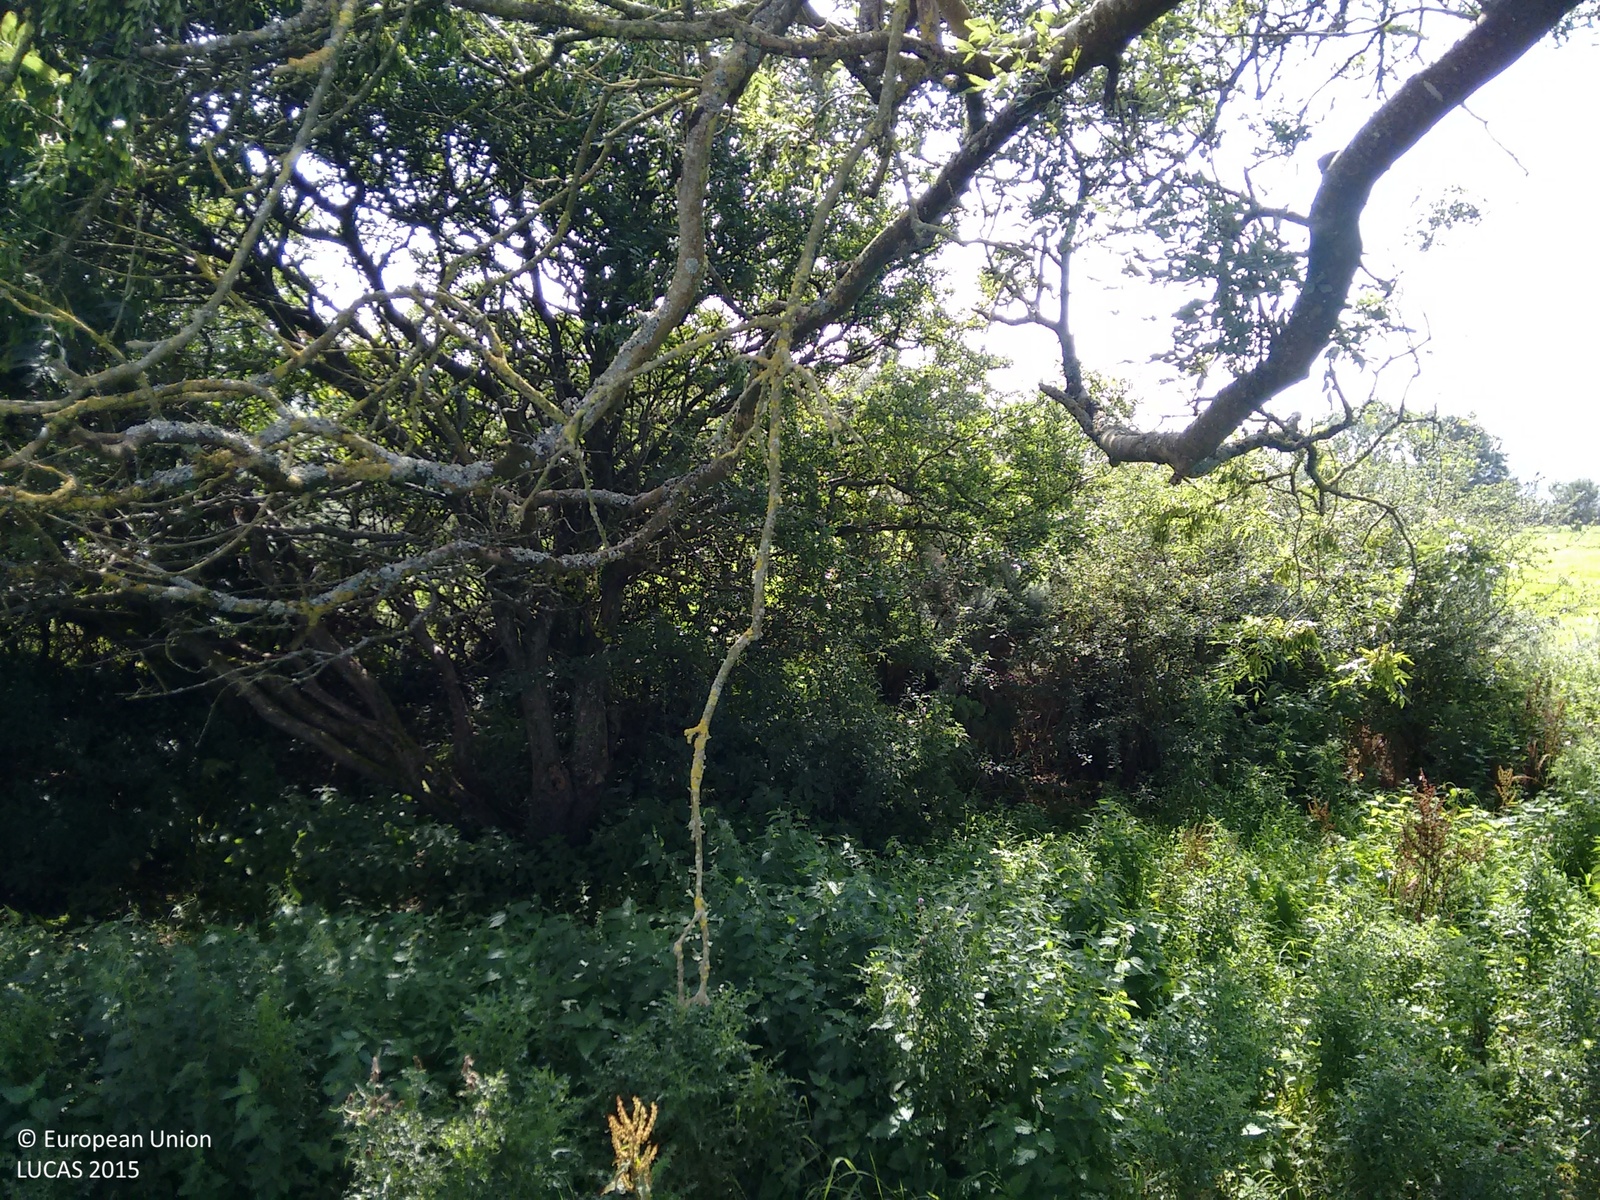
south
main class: Grassland
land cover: Grassland without tree/shrub cover
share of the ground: > 75 %
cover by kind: herbaceous plants 100 %
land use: Agriculture (excluding fallow land and kitchen gardens)
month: August
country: IE
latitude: 52.3426
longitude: -6.5546
